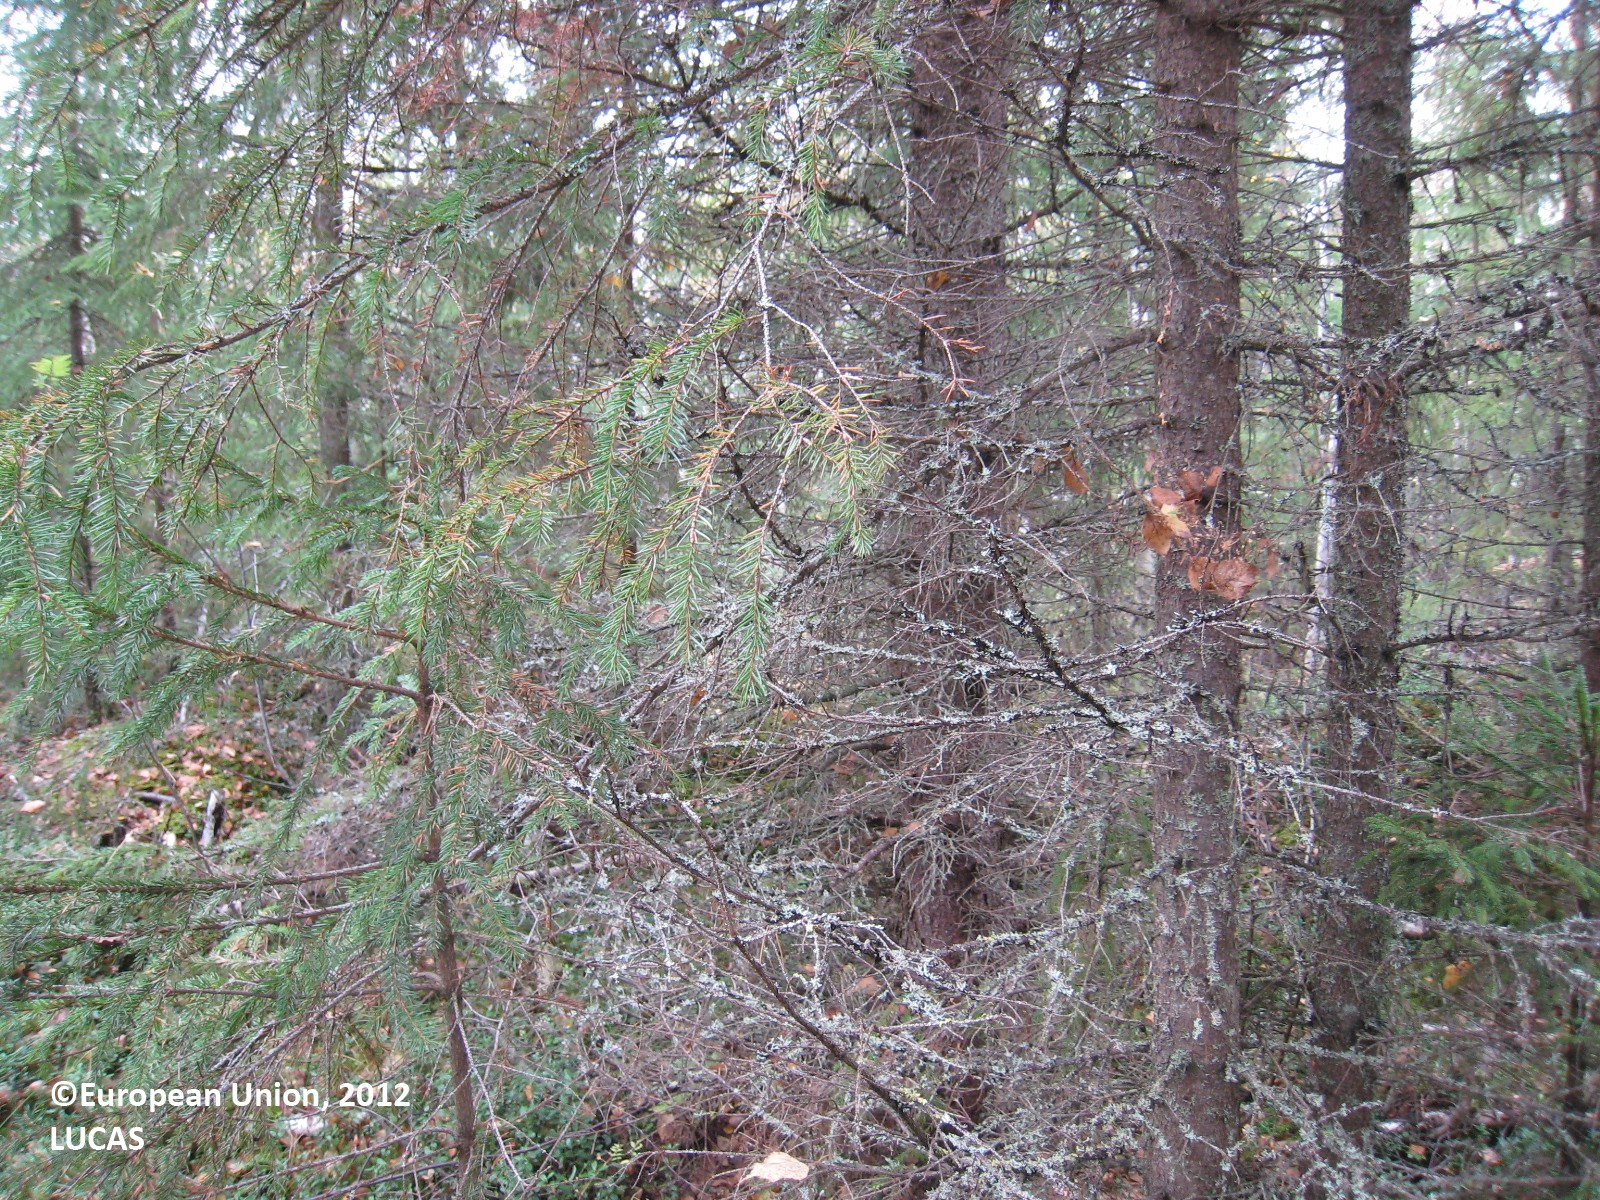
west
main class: Woodland
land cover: Spruce dominated mixed woodland
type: boreal forest
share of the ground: > 75 %
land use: Forestry
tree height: > 5 m
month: September
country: FI
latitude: 62.7608
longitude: 26.2050
